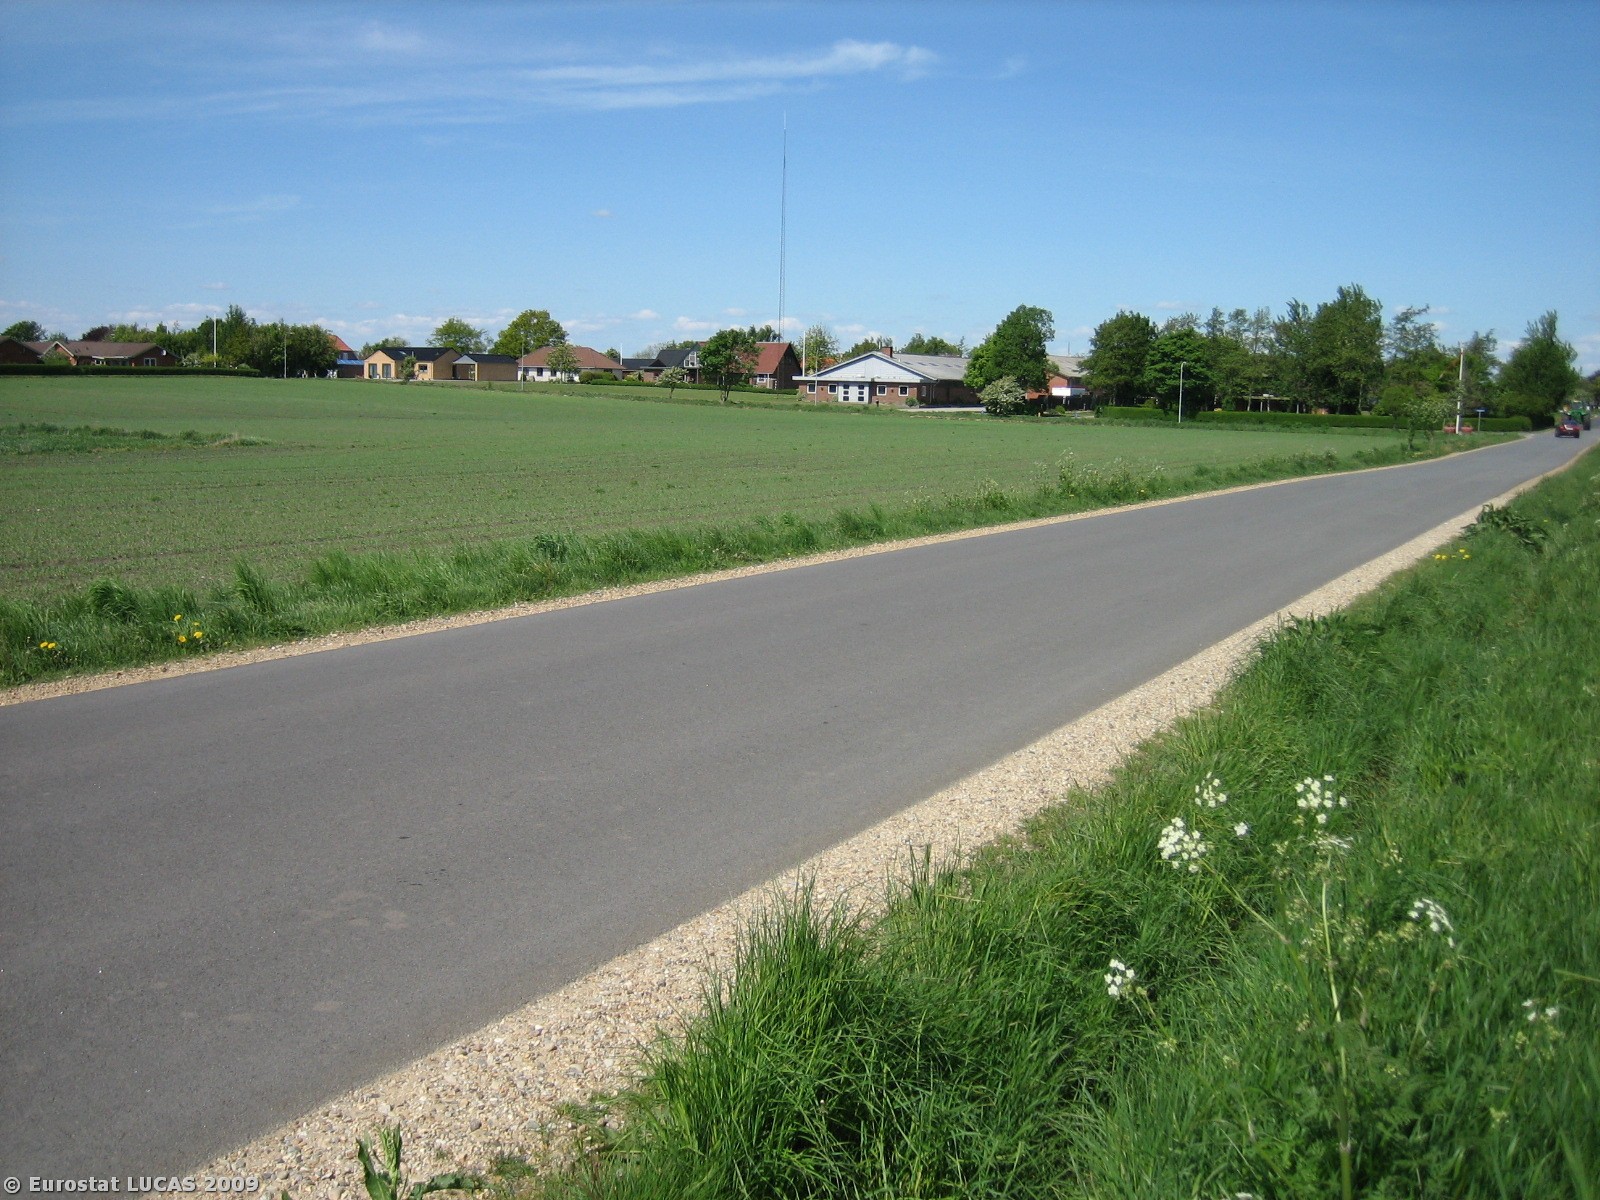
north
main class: Cropland
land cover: Rape and turnip rape
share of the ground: > 75 %
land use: Agriculture (excluding fallow land and kitchen gardens)
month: May
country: DK
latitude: 56.0177
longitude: 8.5417
